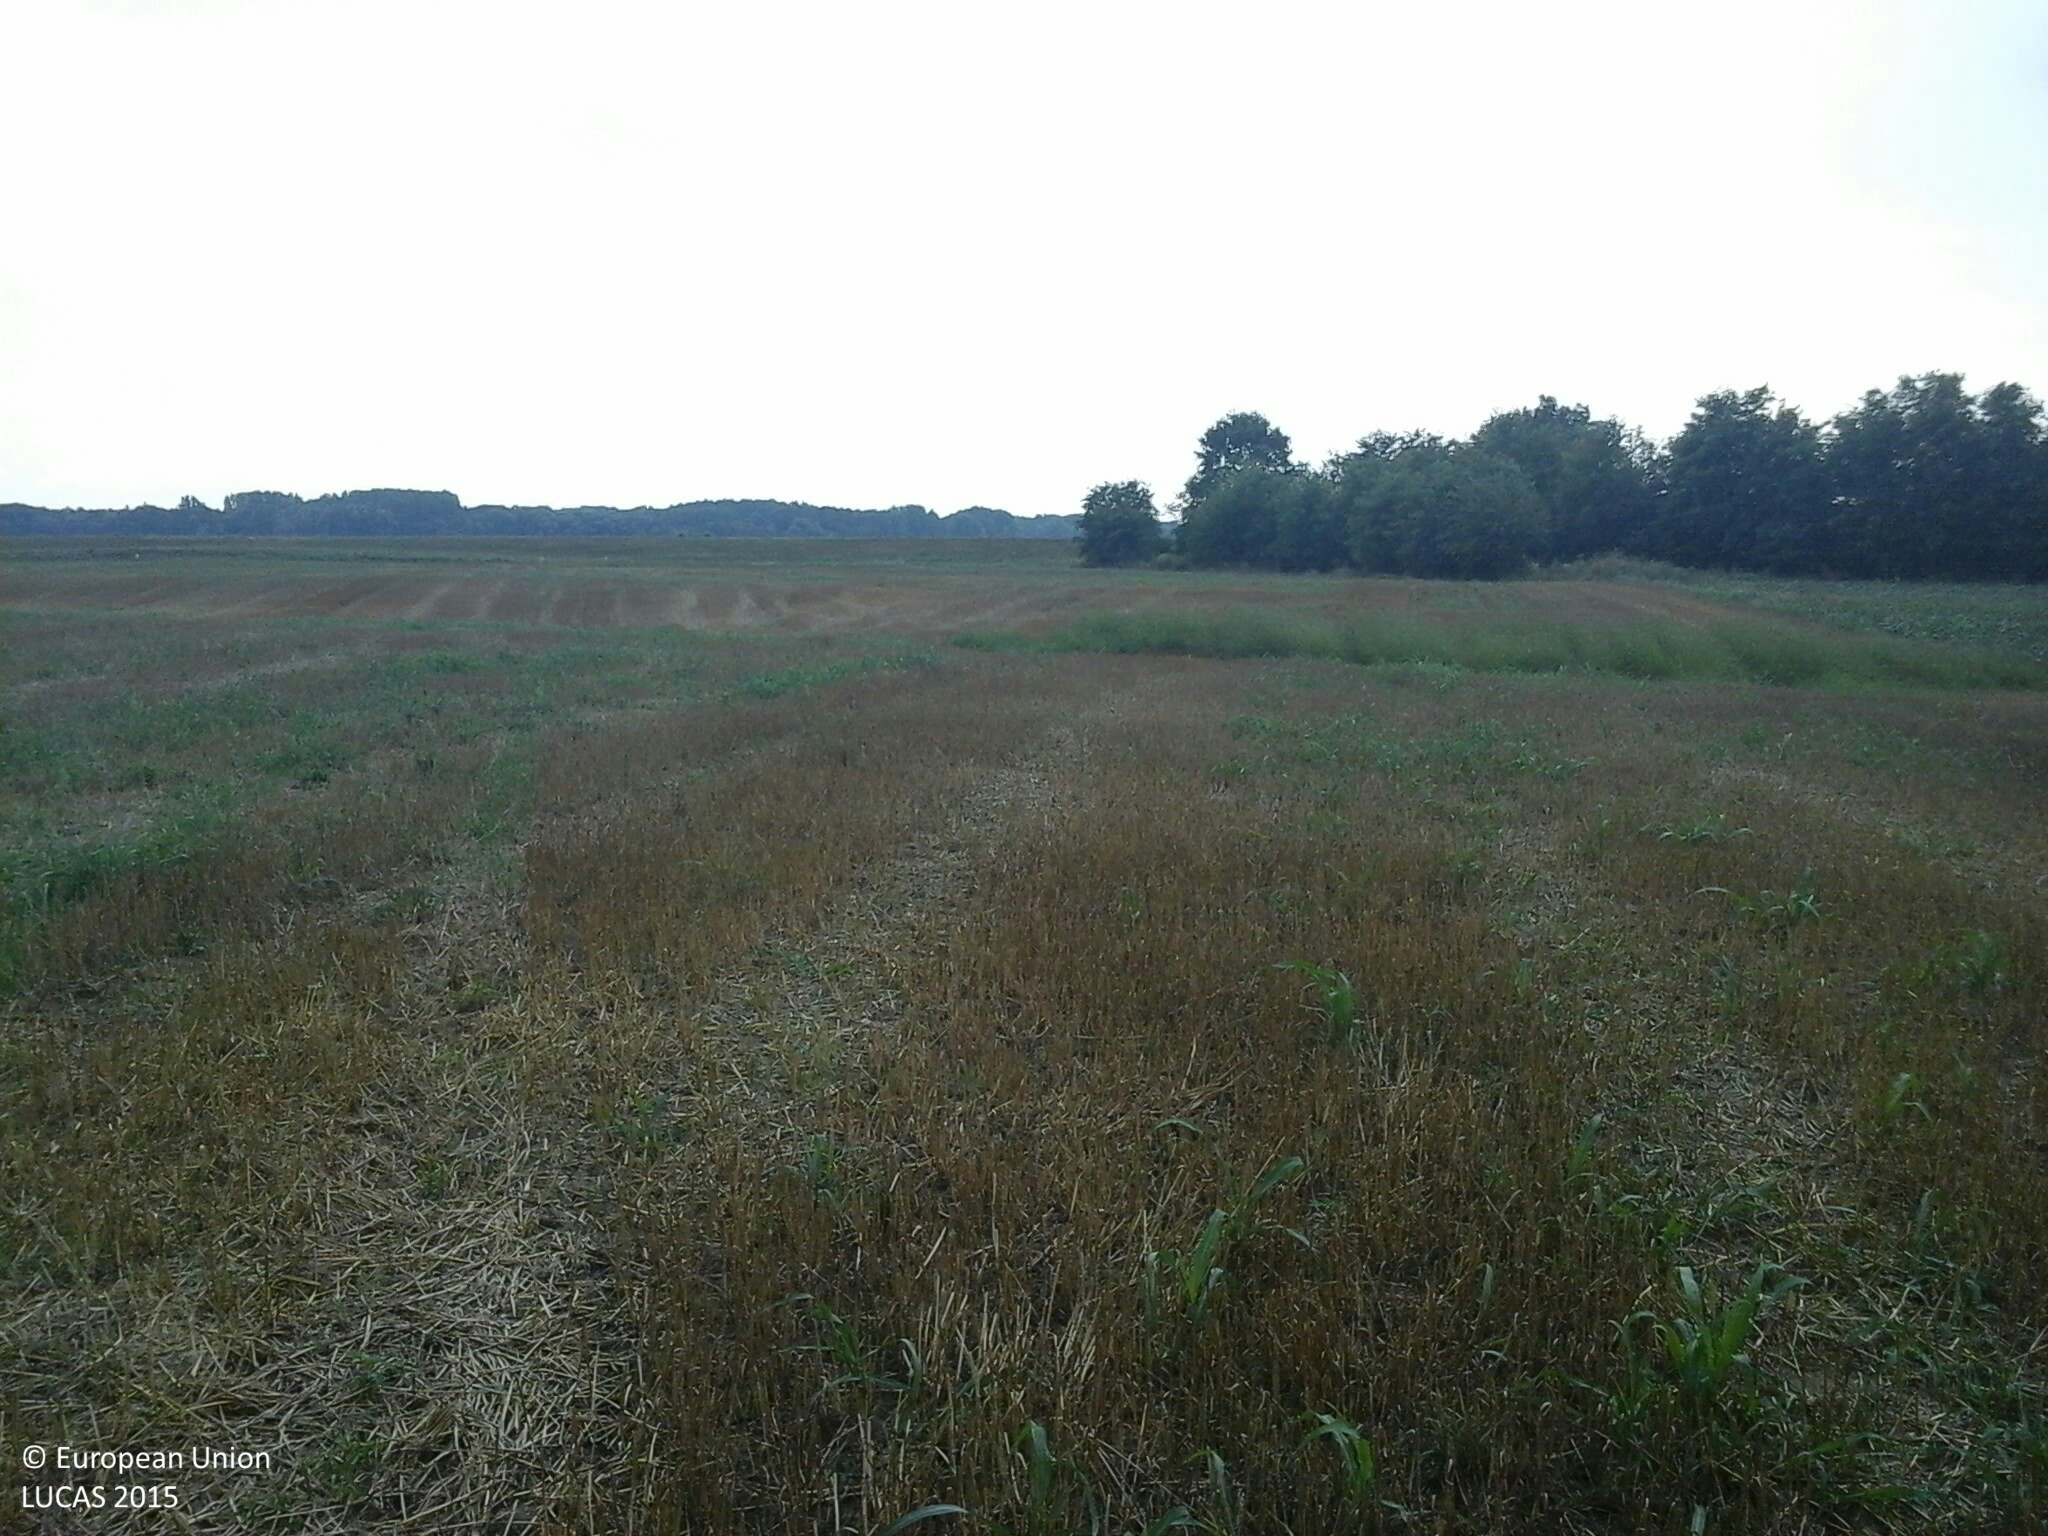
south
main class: Cropland
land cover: Common wheat
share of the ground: 25 - 50 %
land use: Agriculture (excluding fallow land and kitchen gardens)
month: August
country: HU
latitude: 45.8064
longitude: 18.1250
